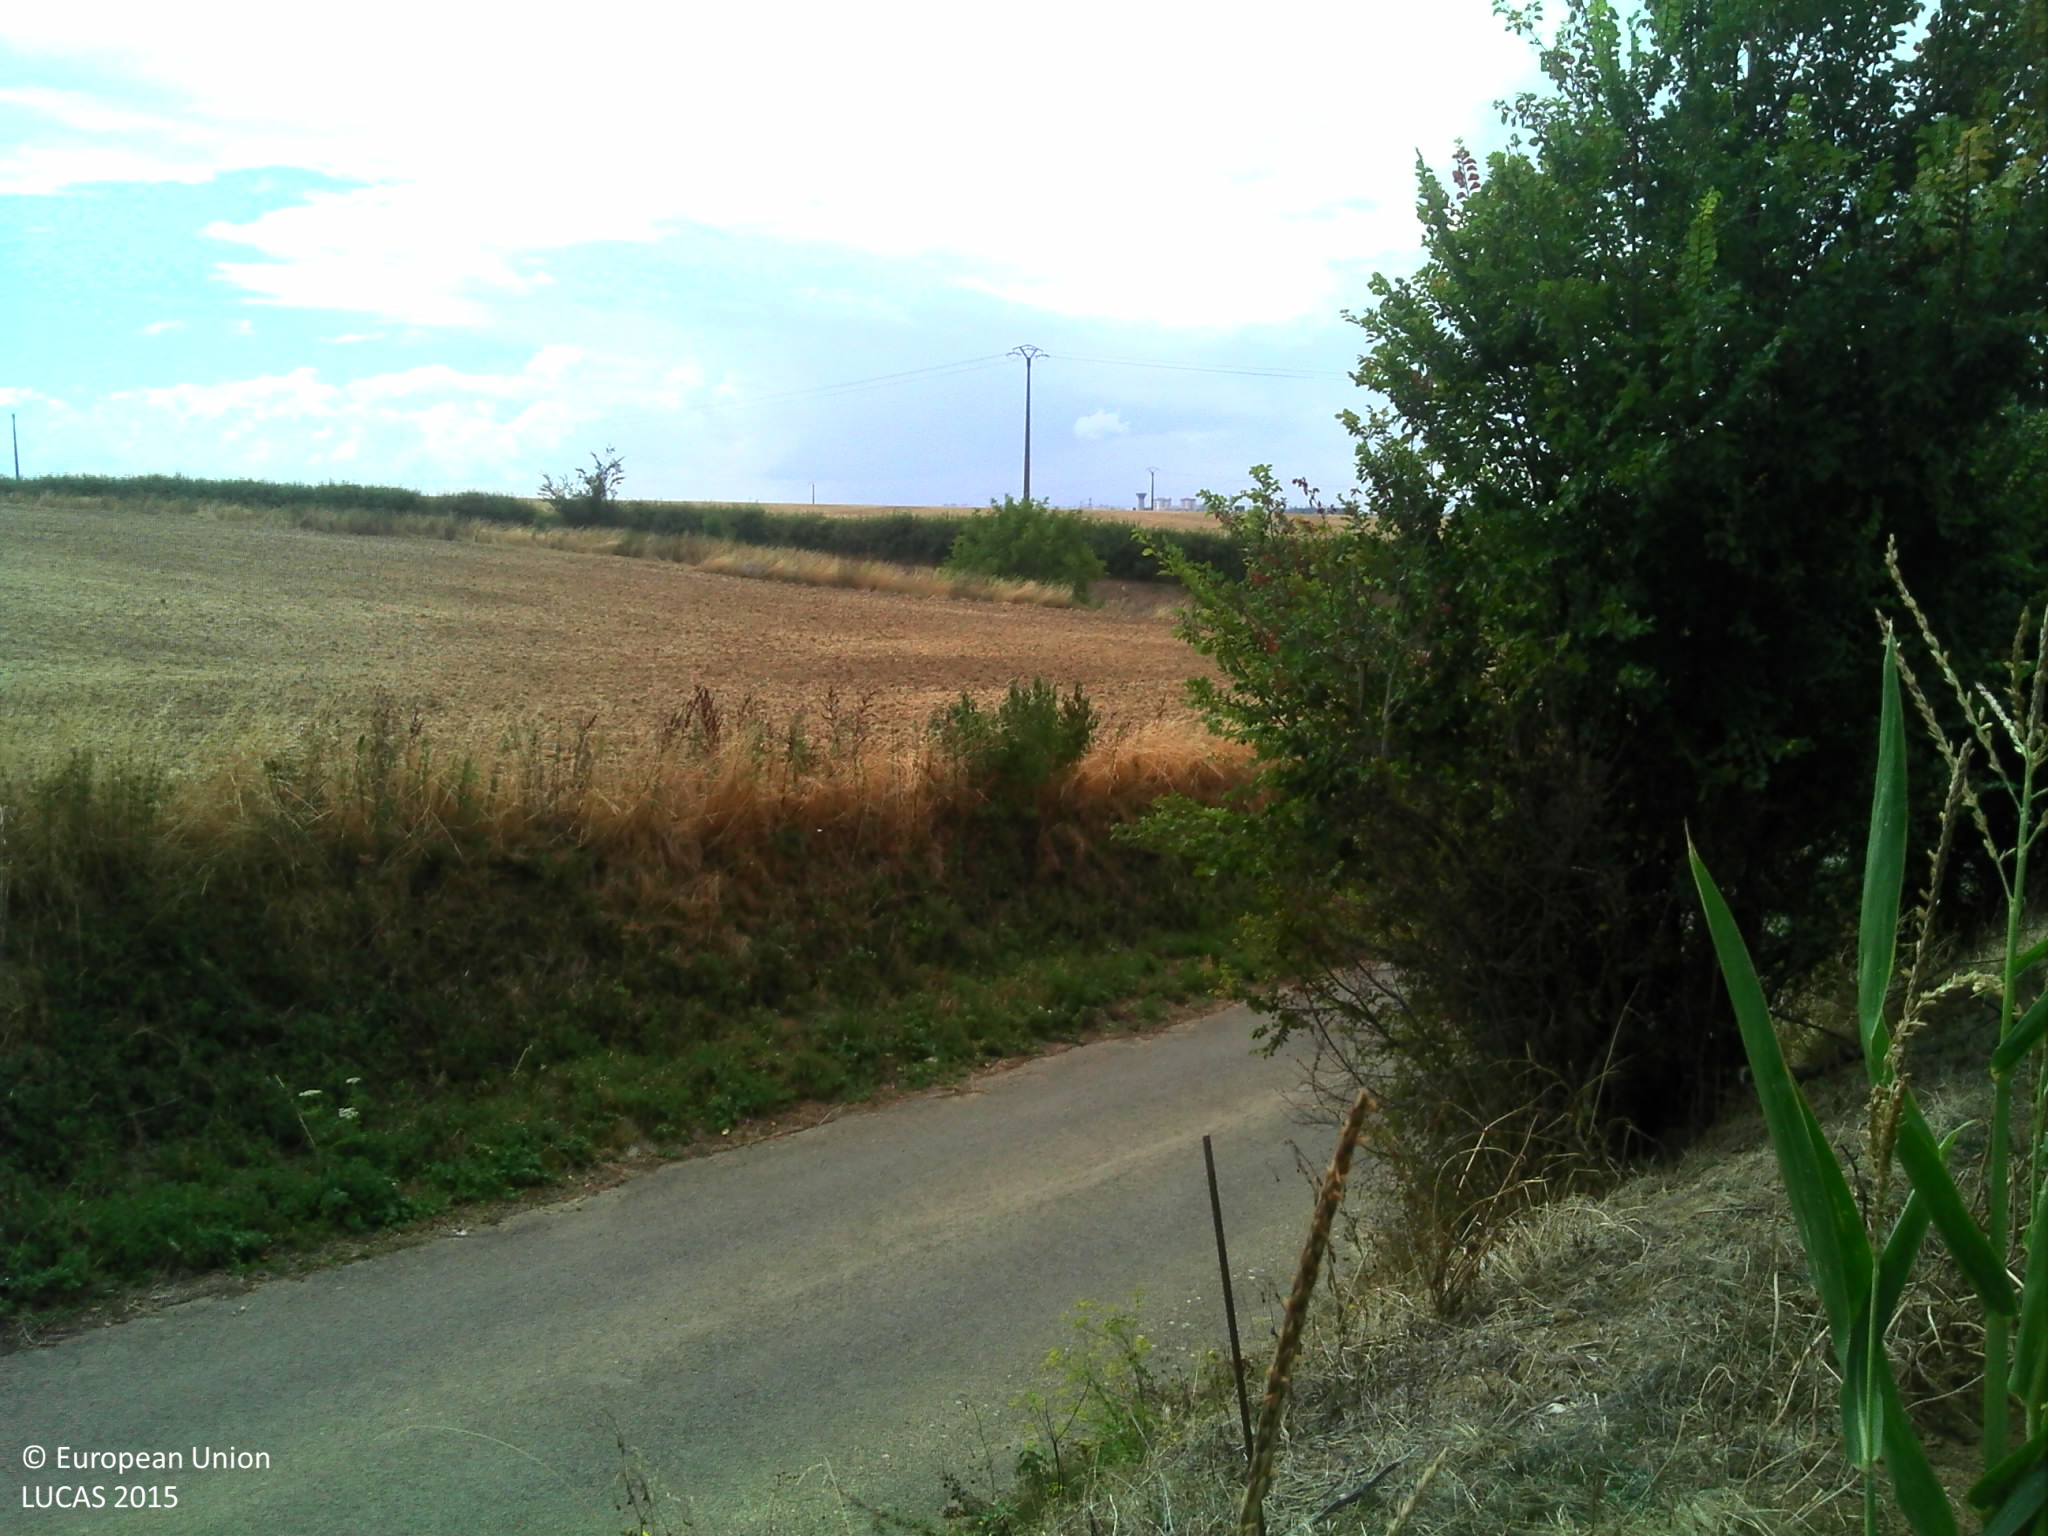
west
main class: Cropland
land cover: Maize
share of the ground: > 75 %
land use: Agriculture (excluding fallow land and kitchen gardens)
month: August
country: FR
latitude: 49.0343
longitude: 2.5065
